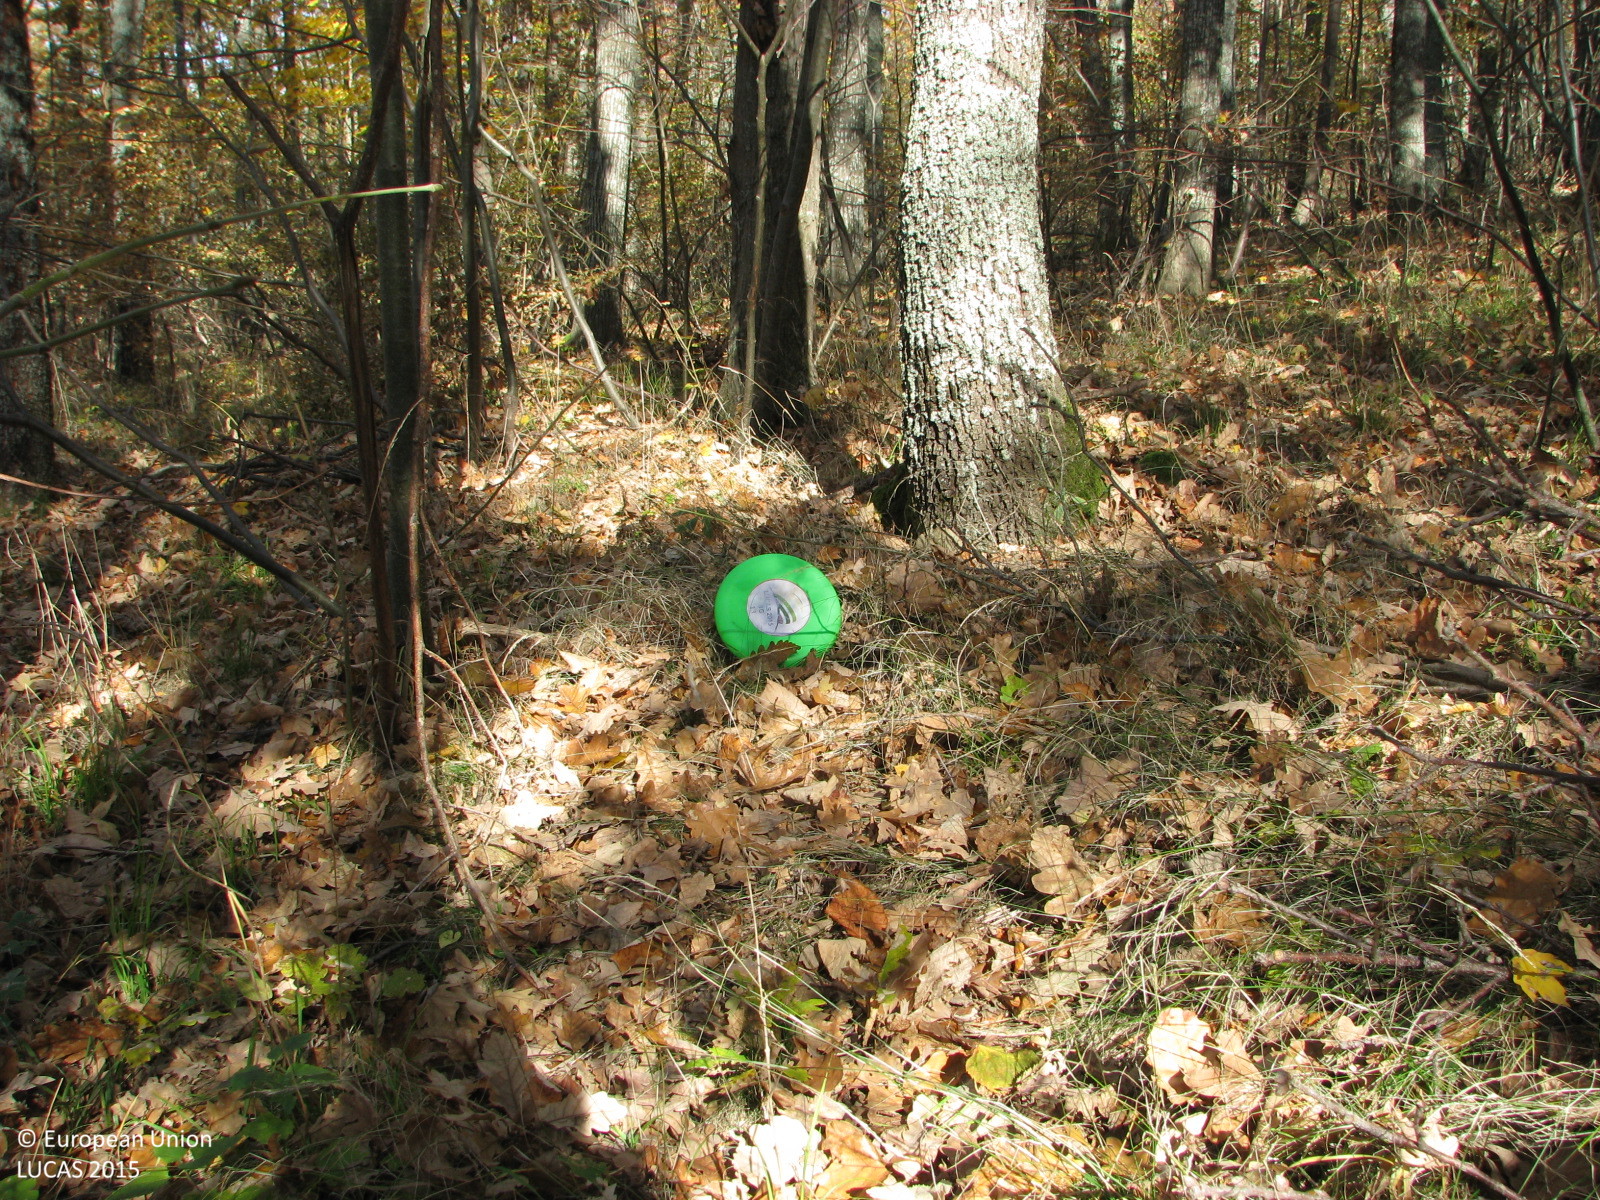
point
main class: Woodland
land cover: Broadleaved woodland
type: mesophytic deciduous forest
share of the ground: 50 - 75 %
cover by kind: broadleaved forest trees 65 %, herbaceous plants 25 %, shrubs 10 %
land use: Forestry
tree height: > 5 m
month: November
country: BG
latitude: 42.0316
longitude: 26.3528
